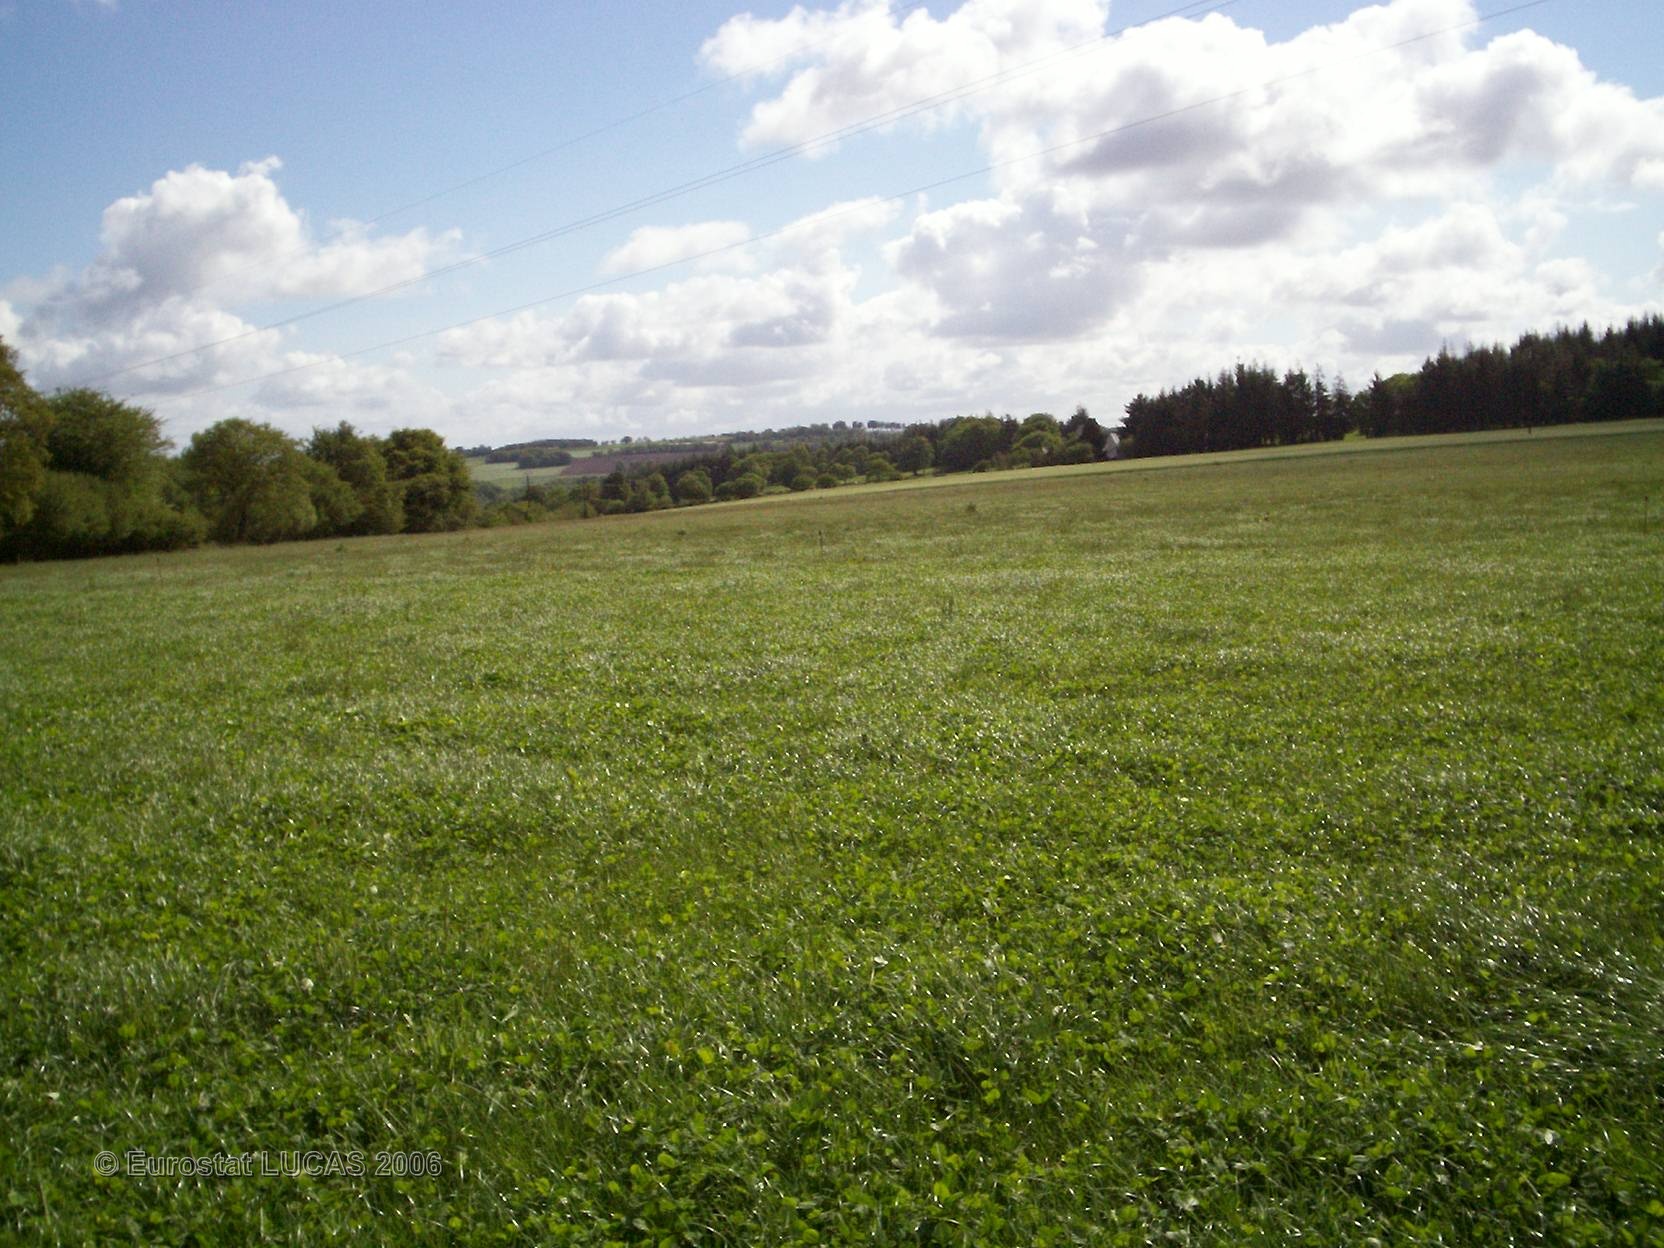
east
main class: Cropland
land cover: Clovers
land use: Agriculture (excluding fallow land and kitchen gardens)
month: May
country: FR
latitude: 48.2534
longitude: -2.9850
